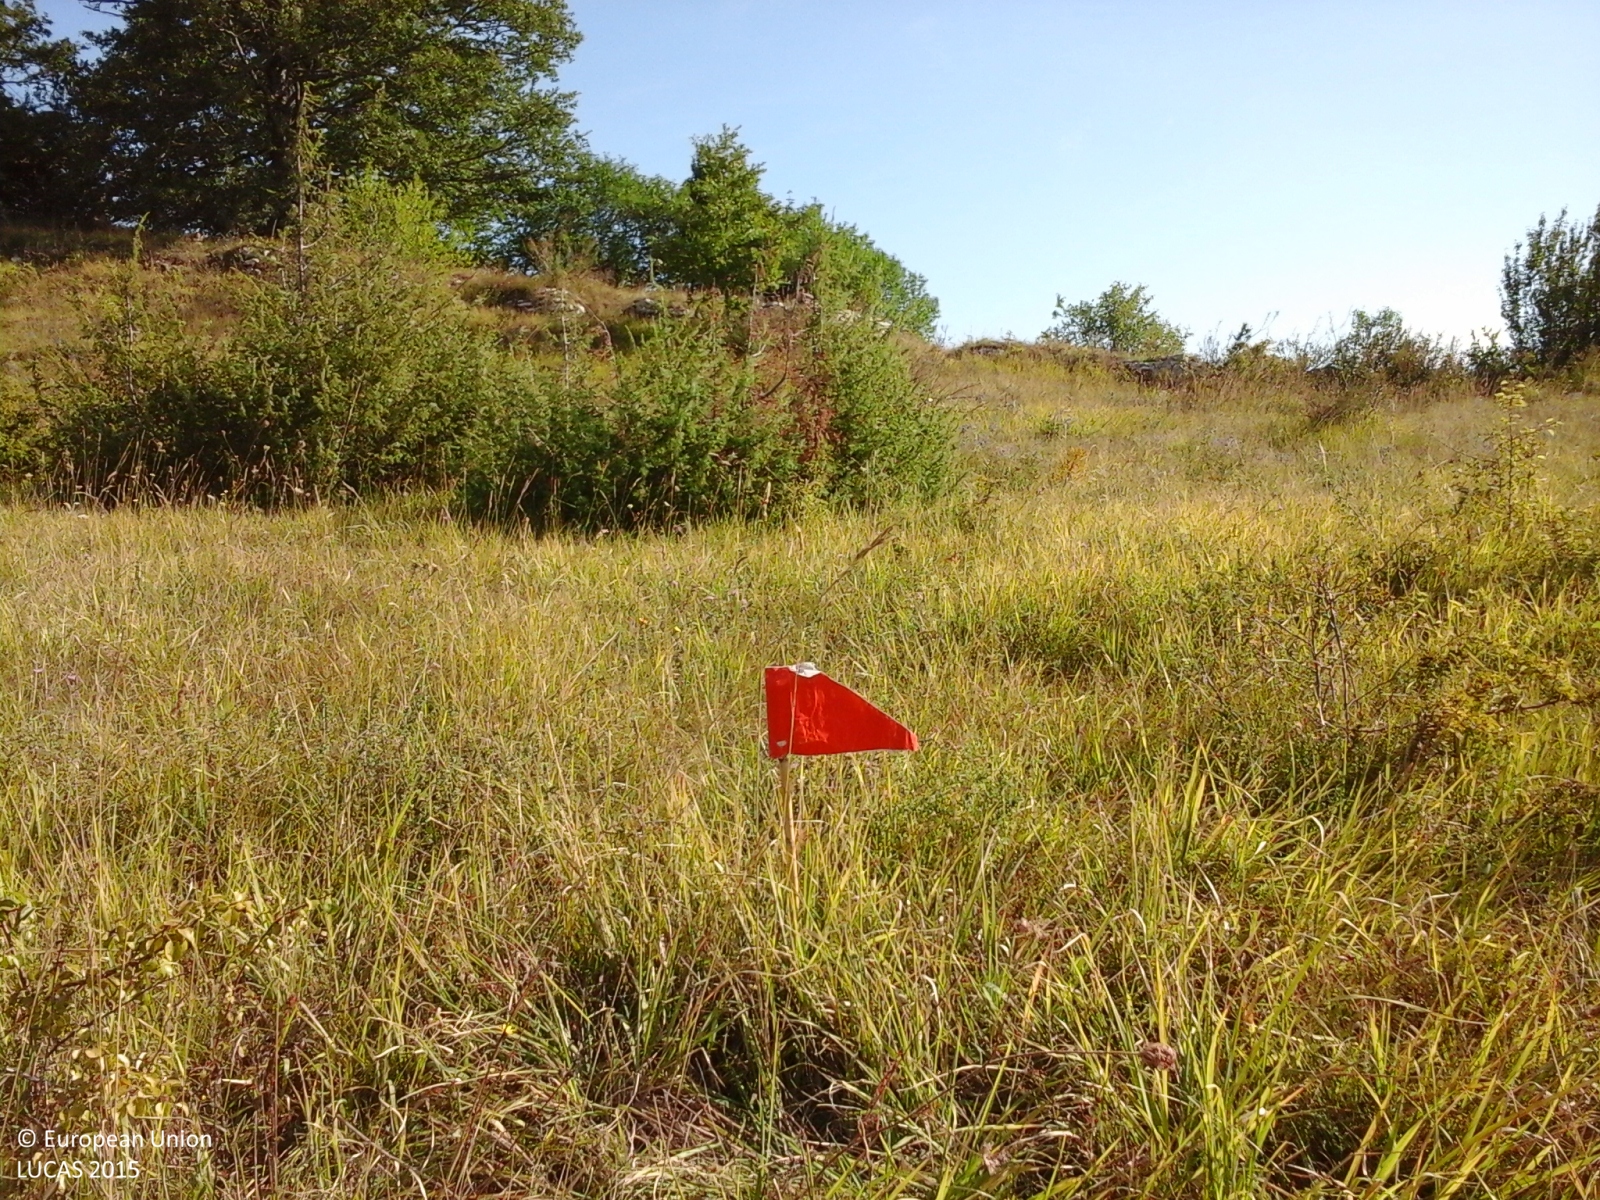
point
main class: Grassland
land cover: Grassland with sparse tree/shrub cover
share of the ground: > 75 %
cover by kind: herbaceous plants 90 %, broadleaved forest trees 5 %, shrubs 5 %
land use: Agriculture (excluding fallow land and kitchen gardens)
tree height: > 5 m
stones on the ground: < 10 %
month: August
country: IT
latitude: 41.7305
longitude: 14.3011
